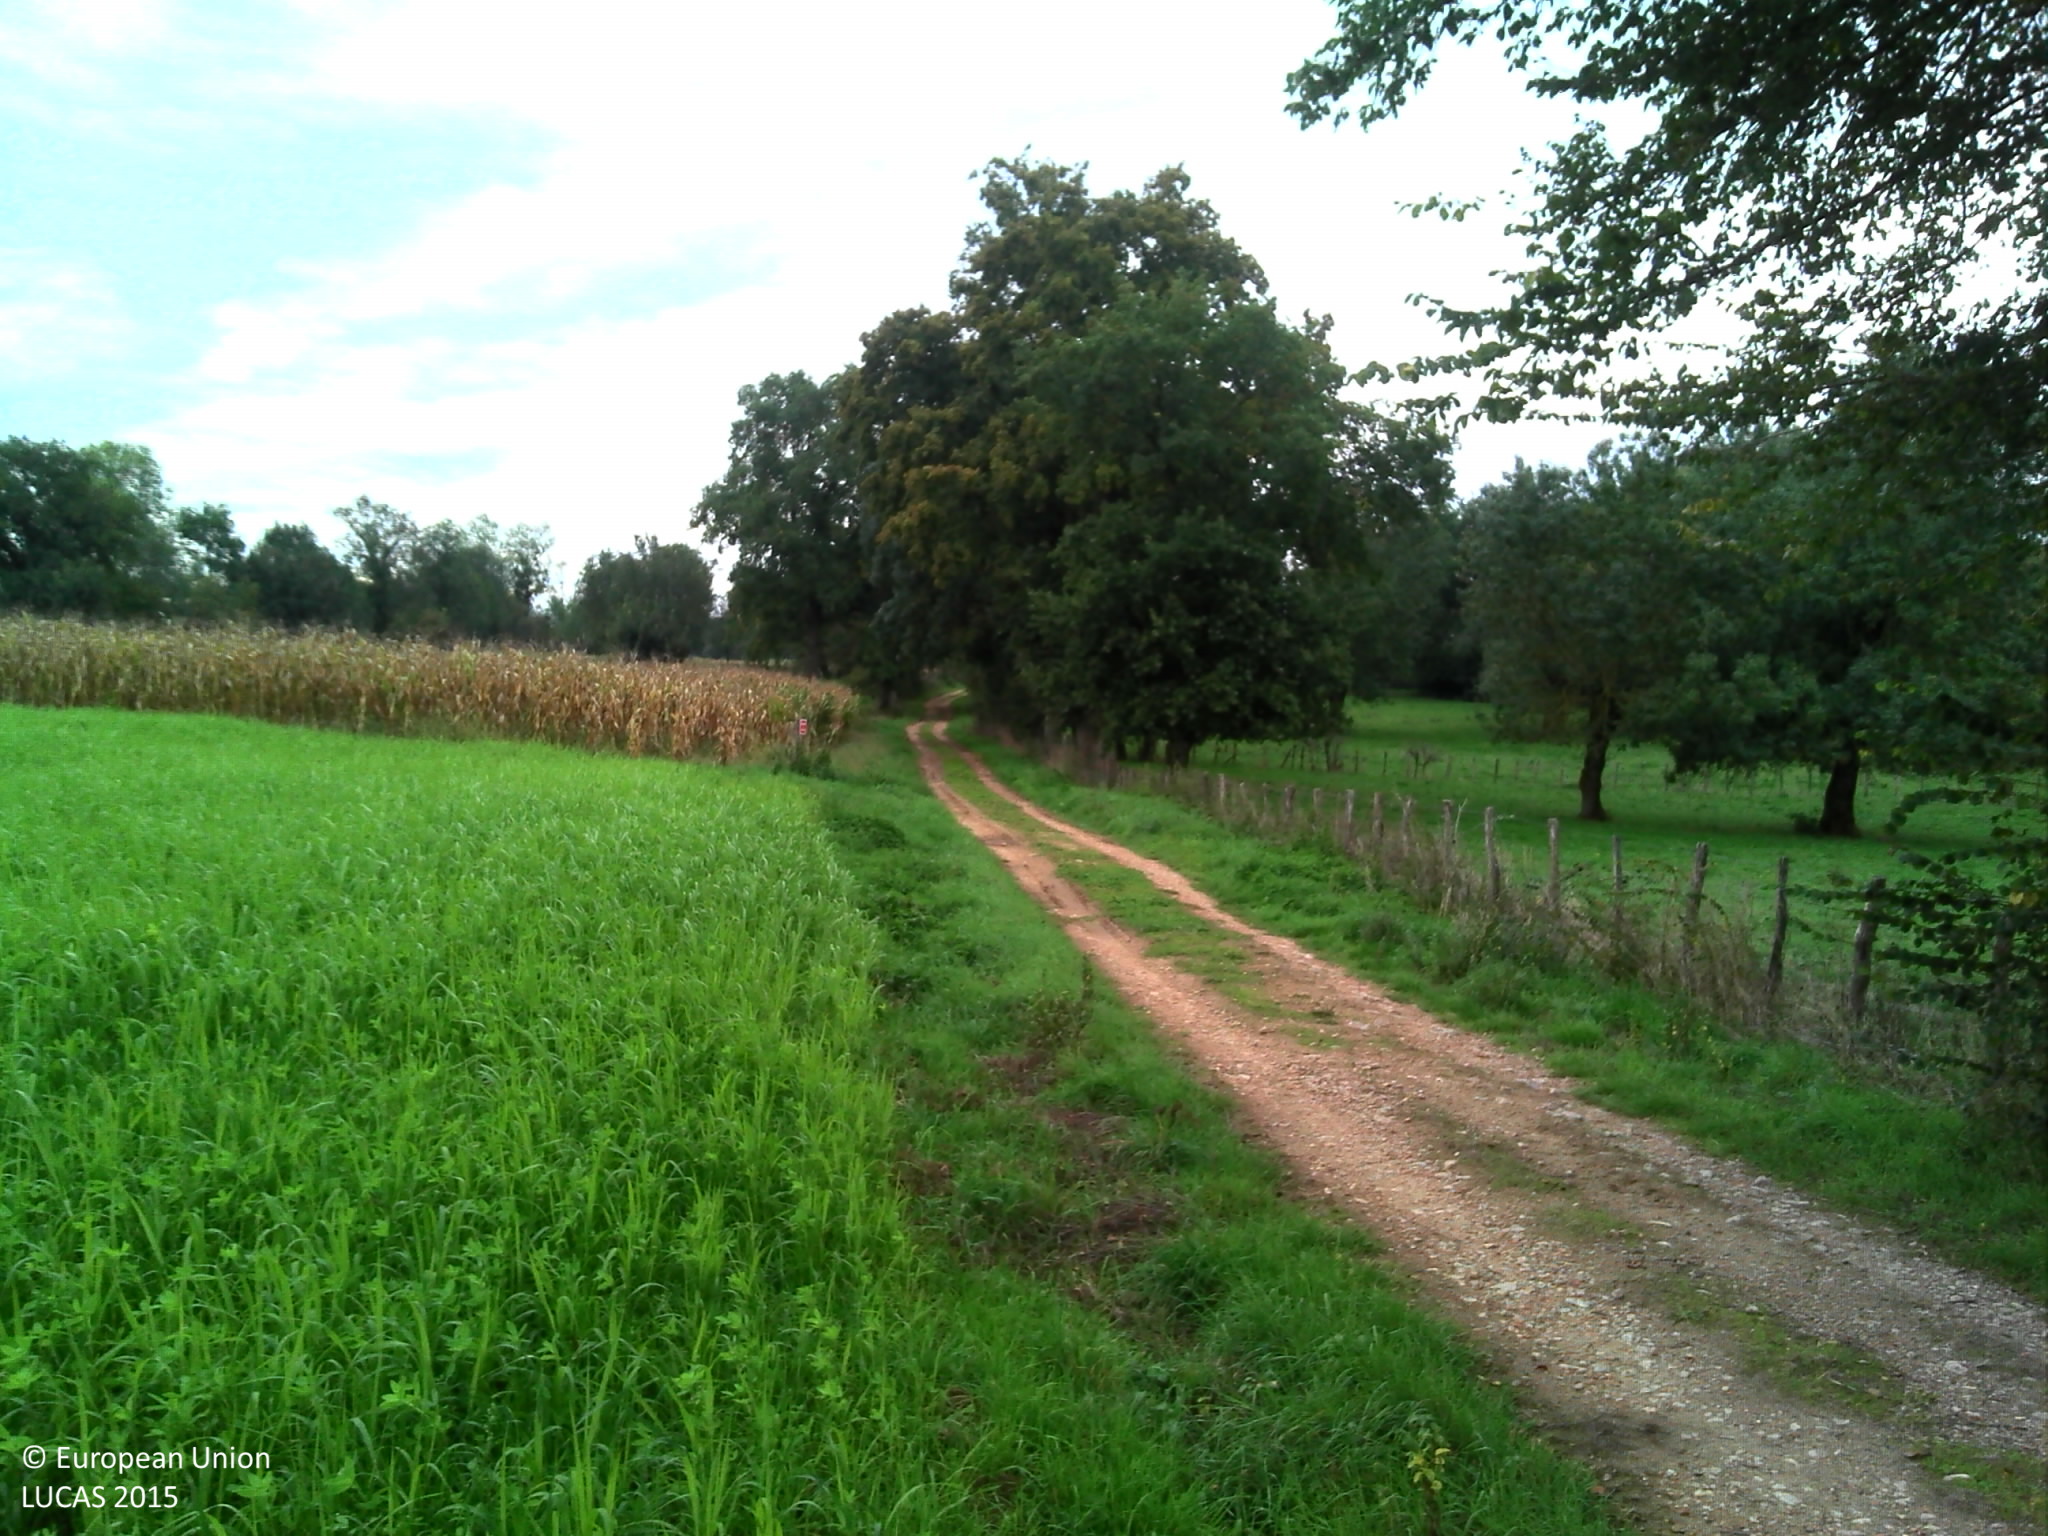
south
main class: Cropland
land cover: Lucerne
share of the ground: > 75 %
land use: Agriculture (excluding fallow land and kitchen gardens)
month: October
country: FR
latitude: 46.4492
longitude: 4.9641
